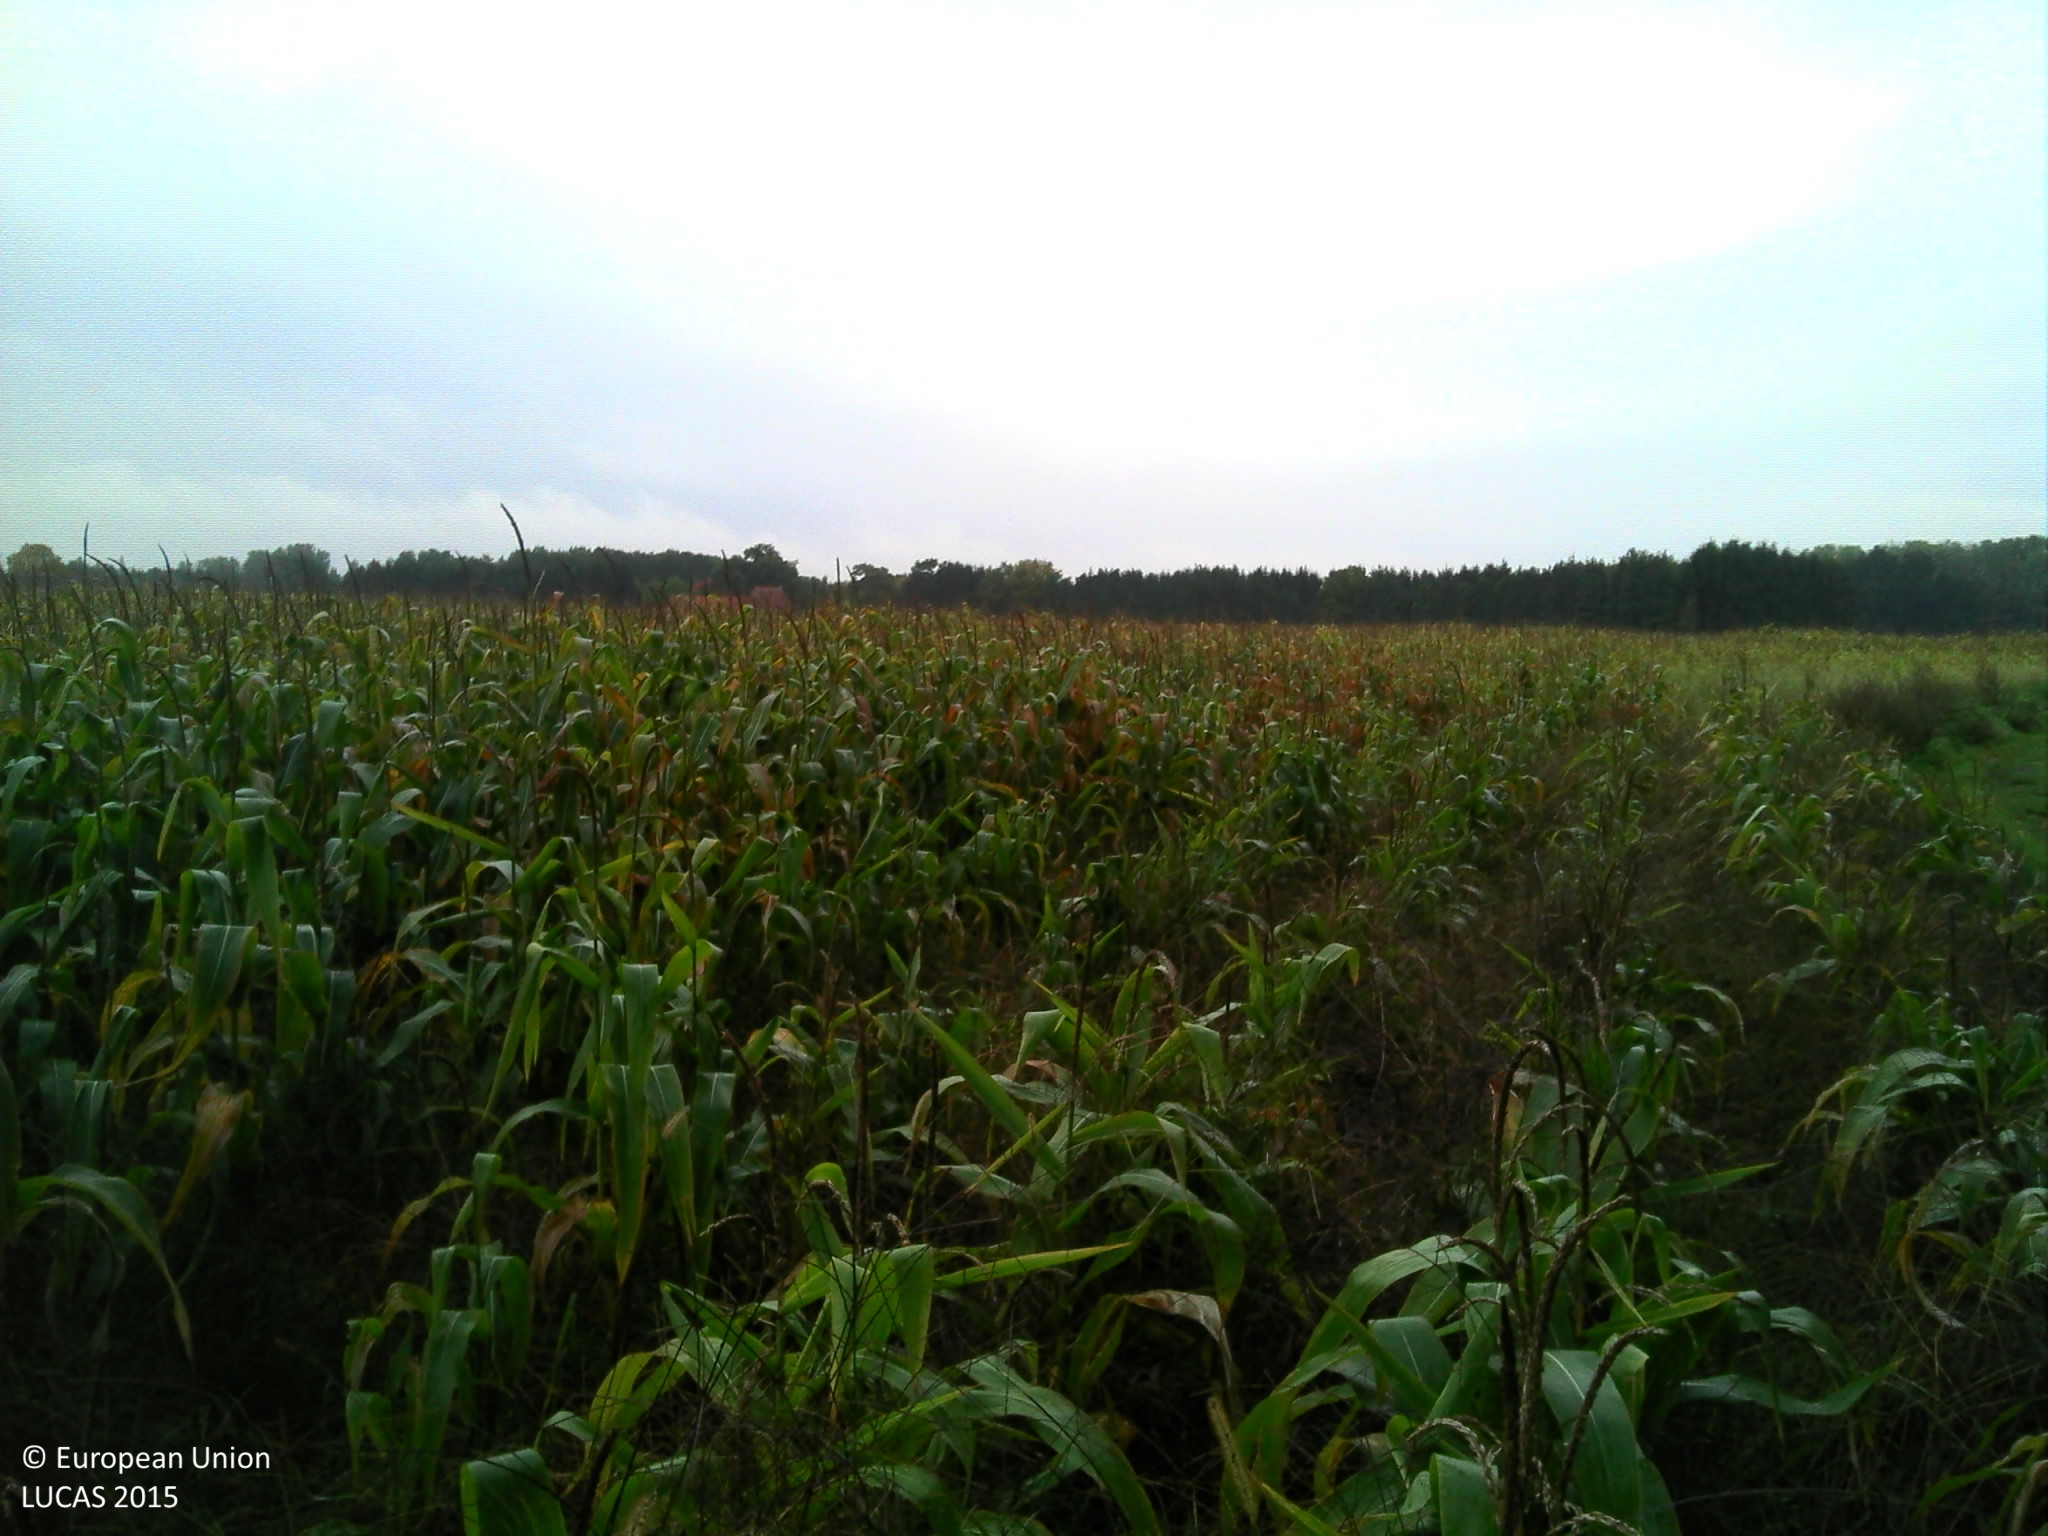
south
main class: Cropland
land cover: Maize
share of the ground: > 75 %
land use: Agriculture (excluding fallow land and kitchen gardens)
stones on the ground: < 10 %
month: October
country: BE
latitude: 51.1086
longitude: 4.7545
